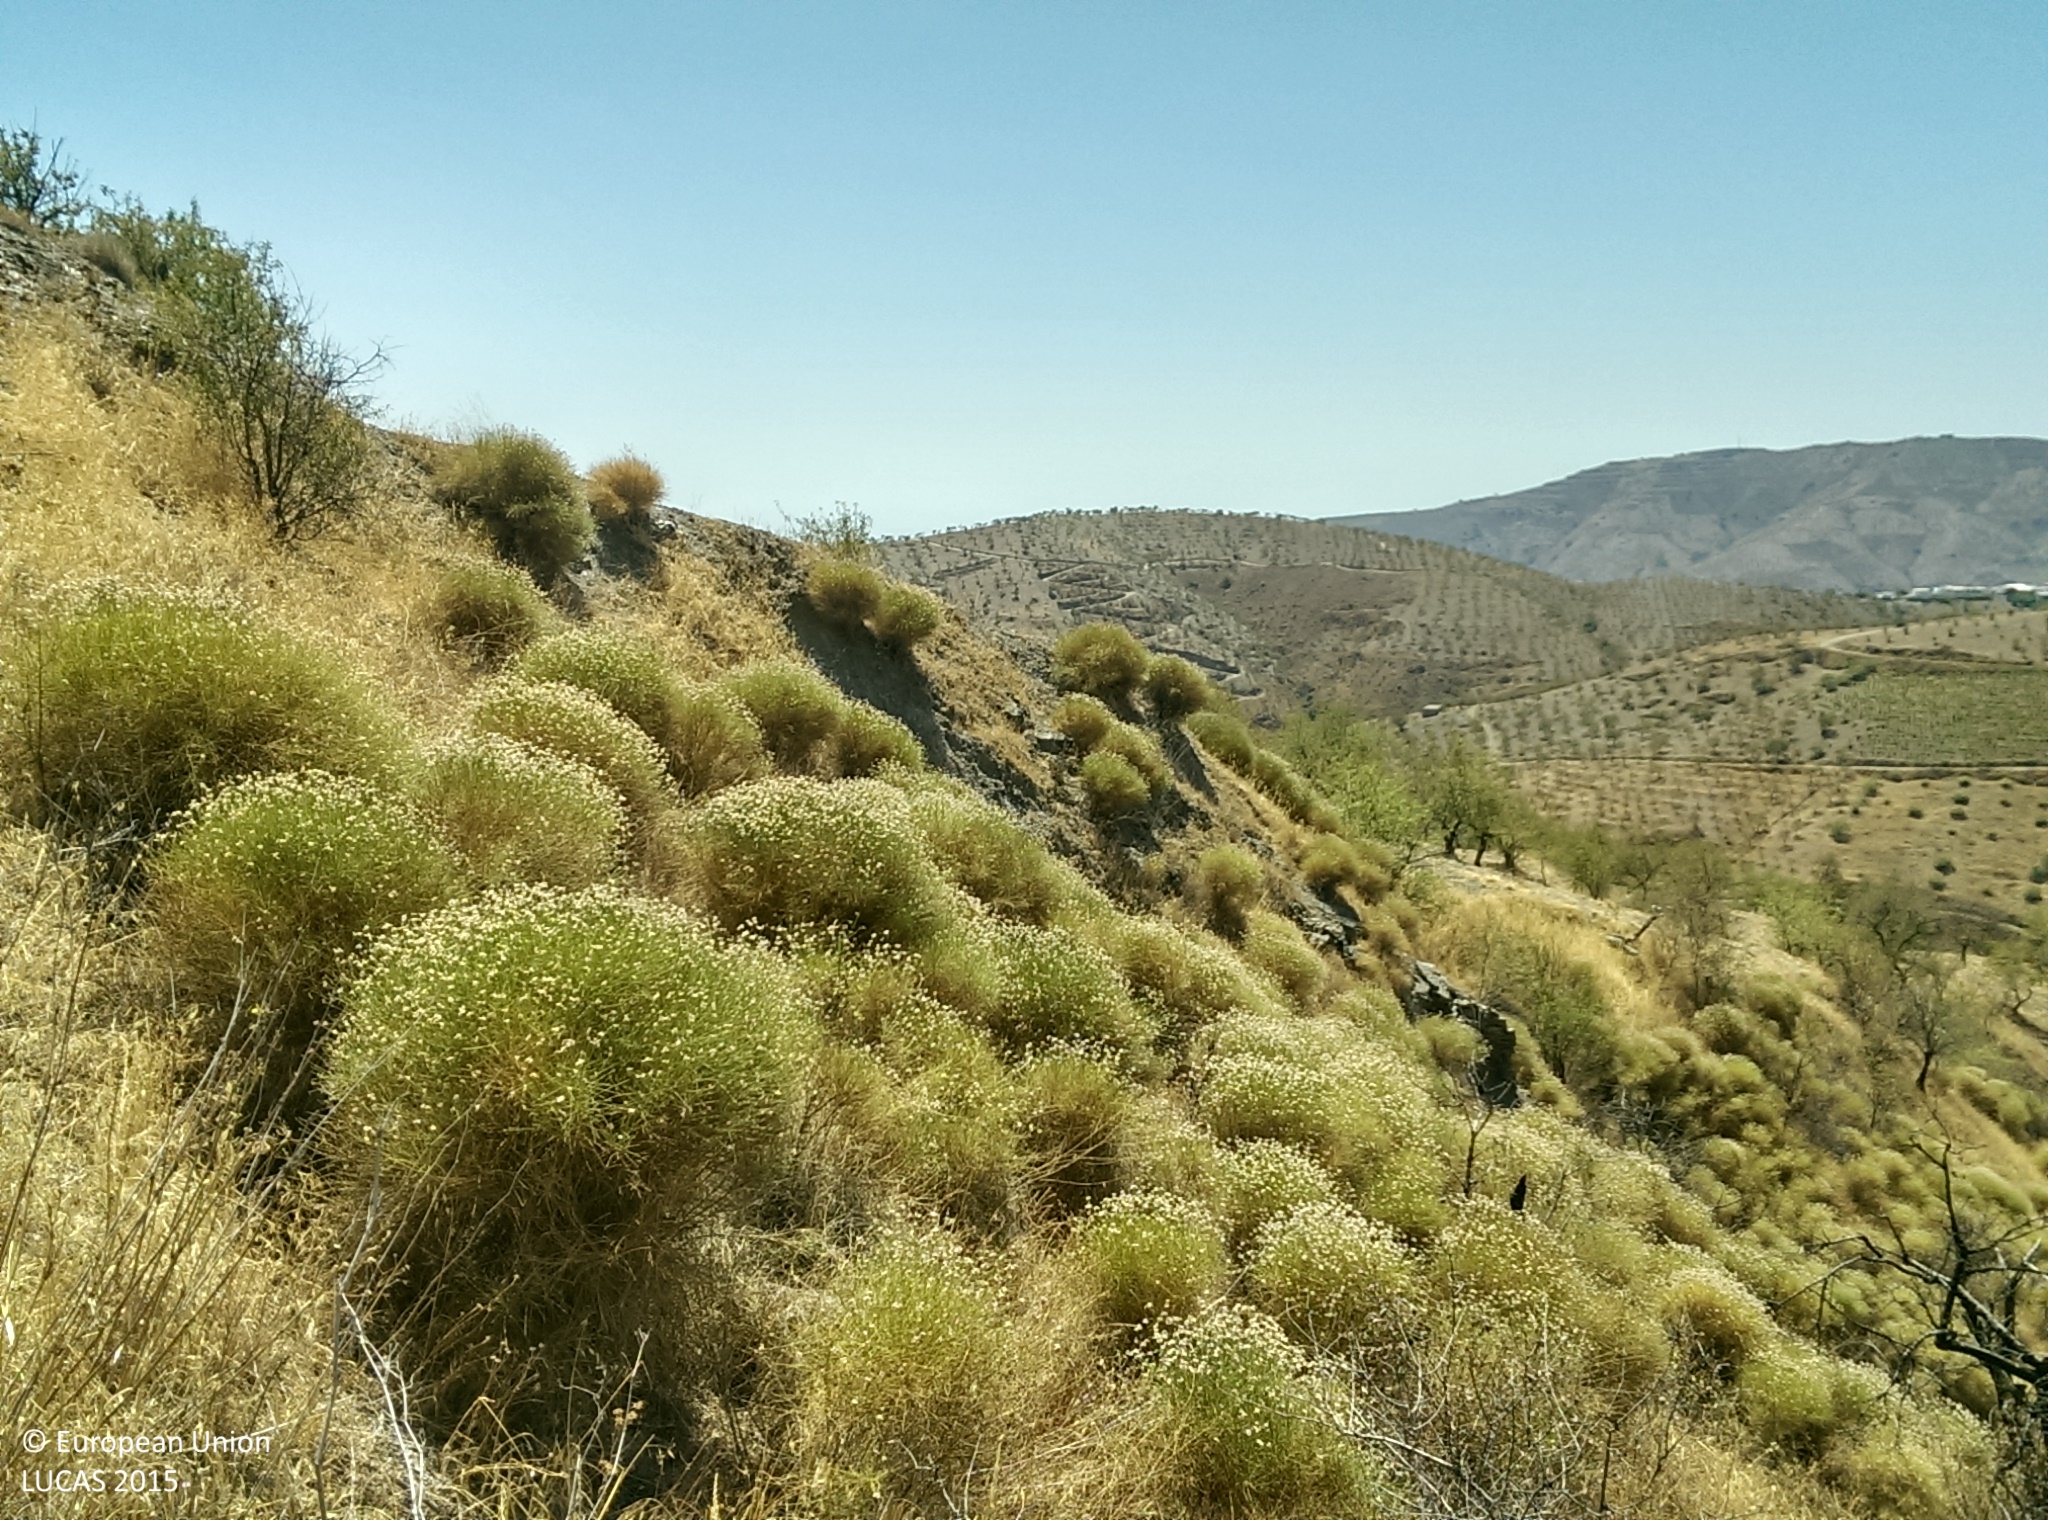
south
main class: Shrubland
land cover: Shrubland with sparse tree cover
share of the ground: > 75 %
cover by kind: shrubs 75 %, herbaceous plants 20 %, broadleaved forest trees 5 %
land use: Abandoned areas
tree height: < 5 m
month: August
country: ES
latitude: 36.8233
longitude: -3.1980
